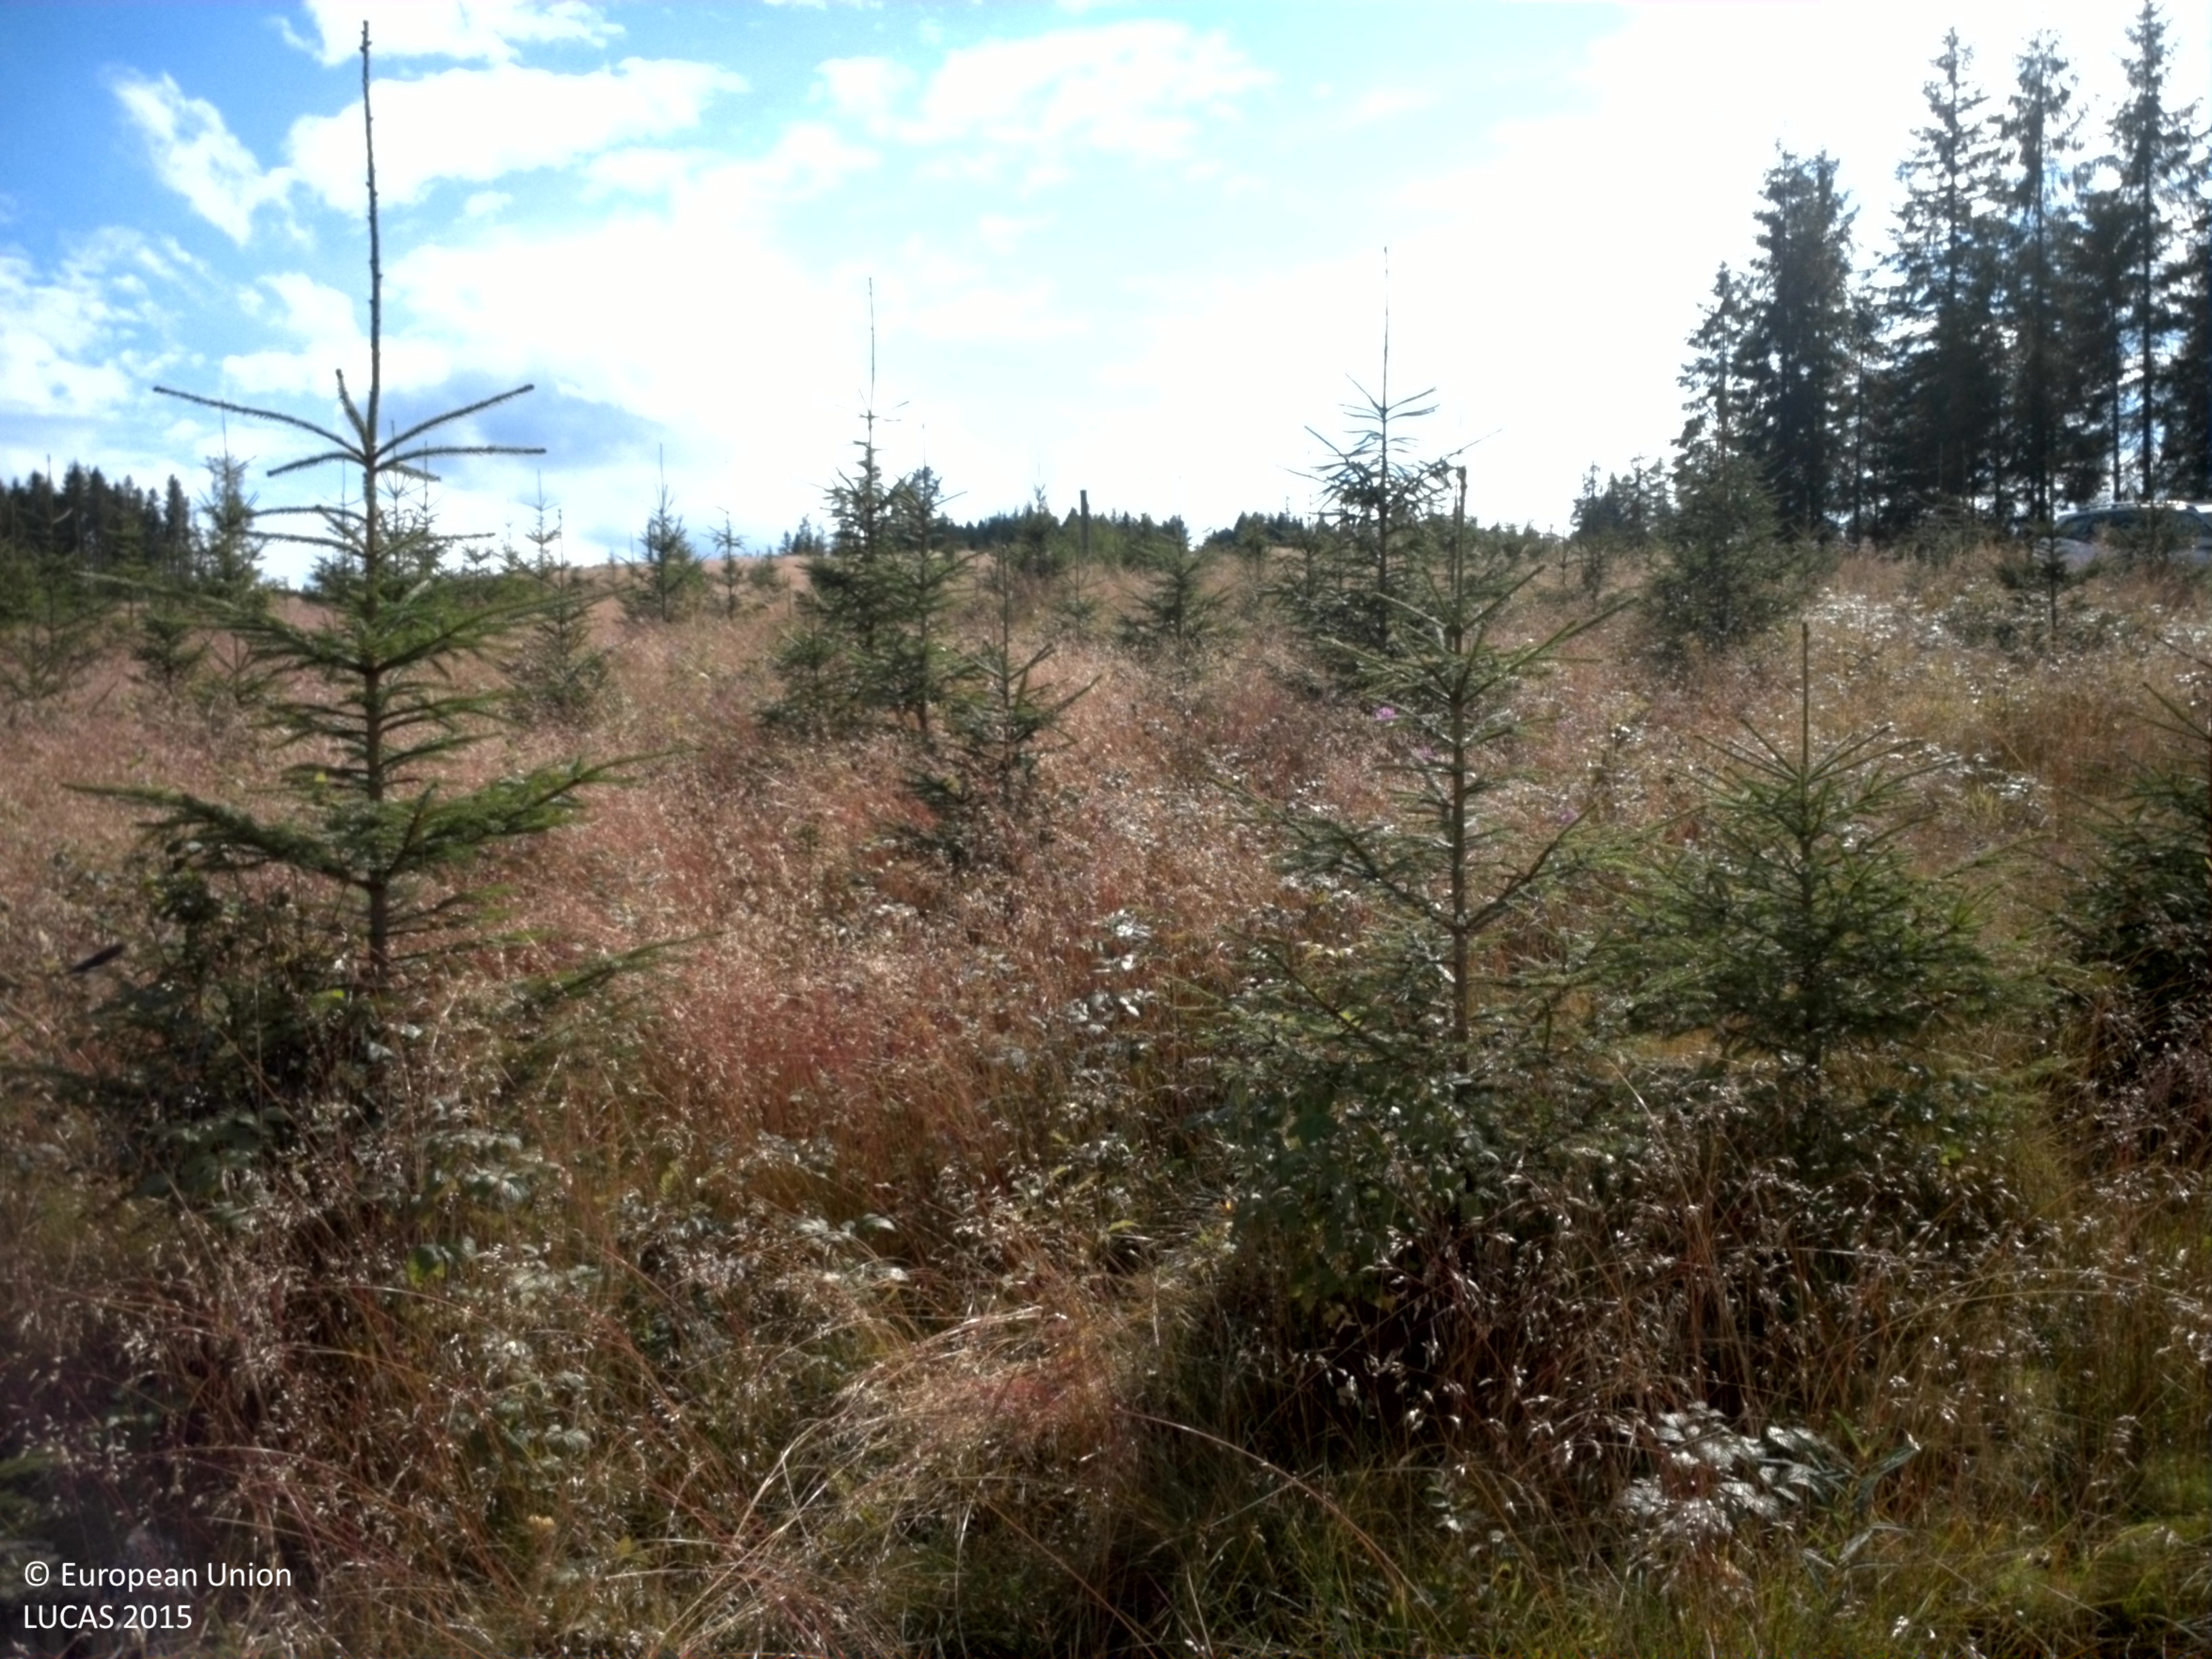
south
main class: Woodland
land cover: Spruce dominated coniferous woodland
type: boreal forest
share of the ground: 10 - 25 %
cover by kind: herbaceous plants 45 %, coniferous forest trees 25 %, shrubs 25 %
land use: Forestry
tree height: < 5 m
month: August
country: SE
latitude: 60.1219
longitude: 13.3921
